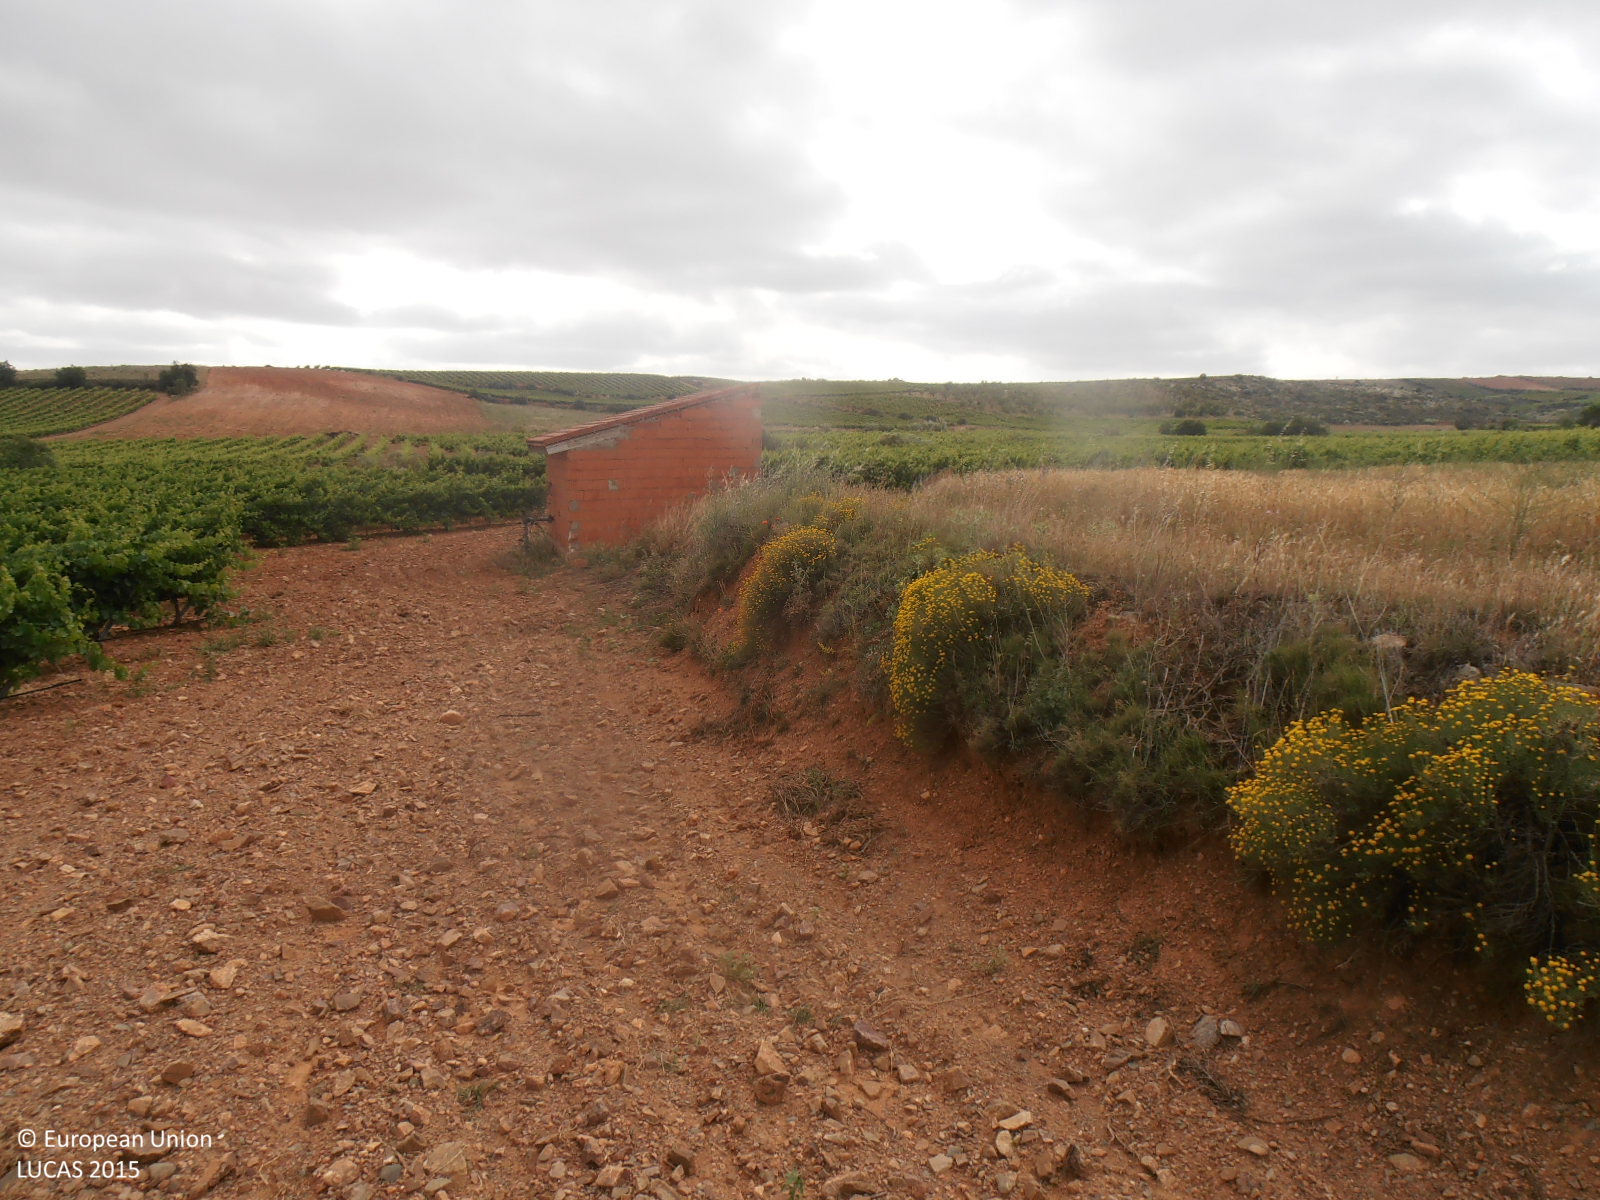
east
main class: Cropland
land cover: Vineyards
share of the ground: 25 - 50 %
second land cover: Other bare soil
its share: > 75 %
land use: Agriculture (excluding fallow land and kitchen gardens)
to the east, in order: Vineyards; Other bare soil; Grass margins; Vineyards; Tracks; Vineyards; Inland fresh running water; Vineyards; Grass margins; Spontaneously vegetated surfaces
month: June
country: ES
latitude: 41.3033
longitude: -1.1880
